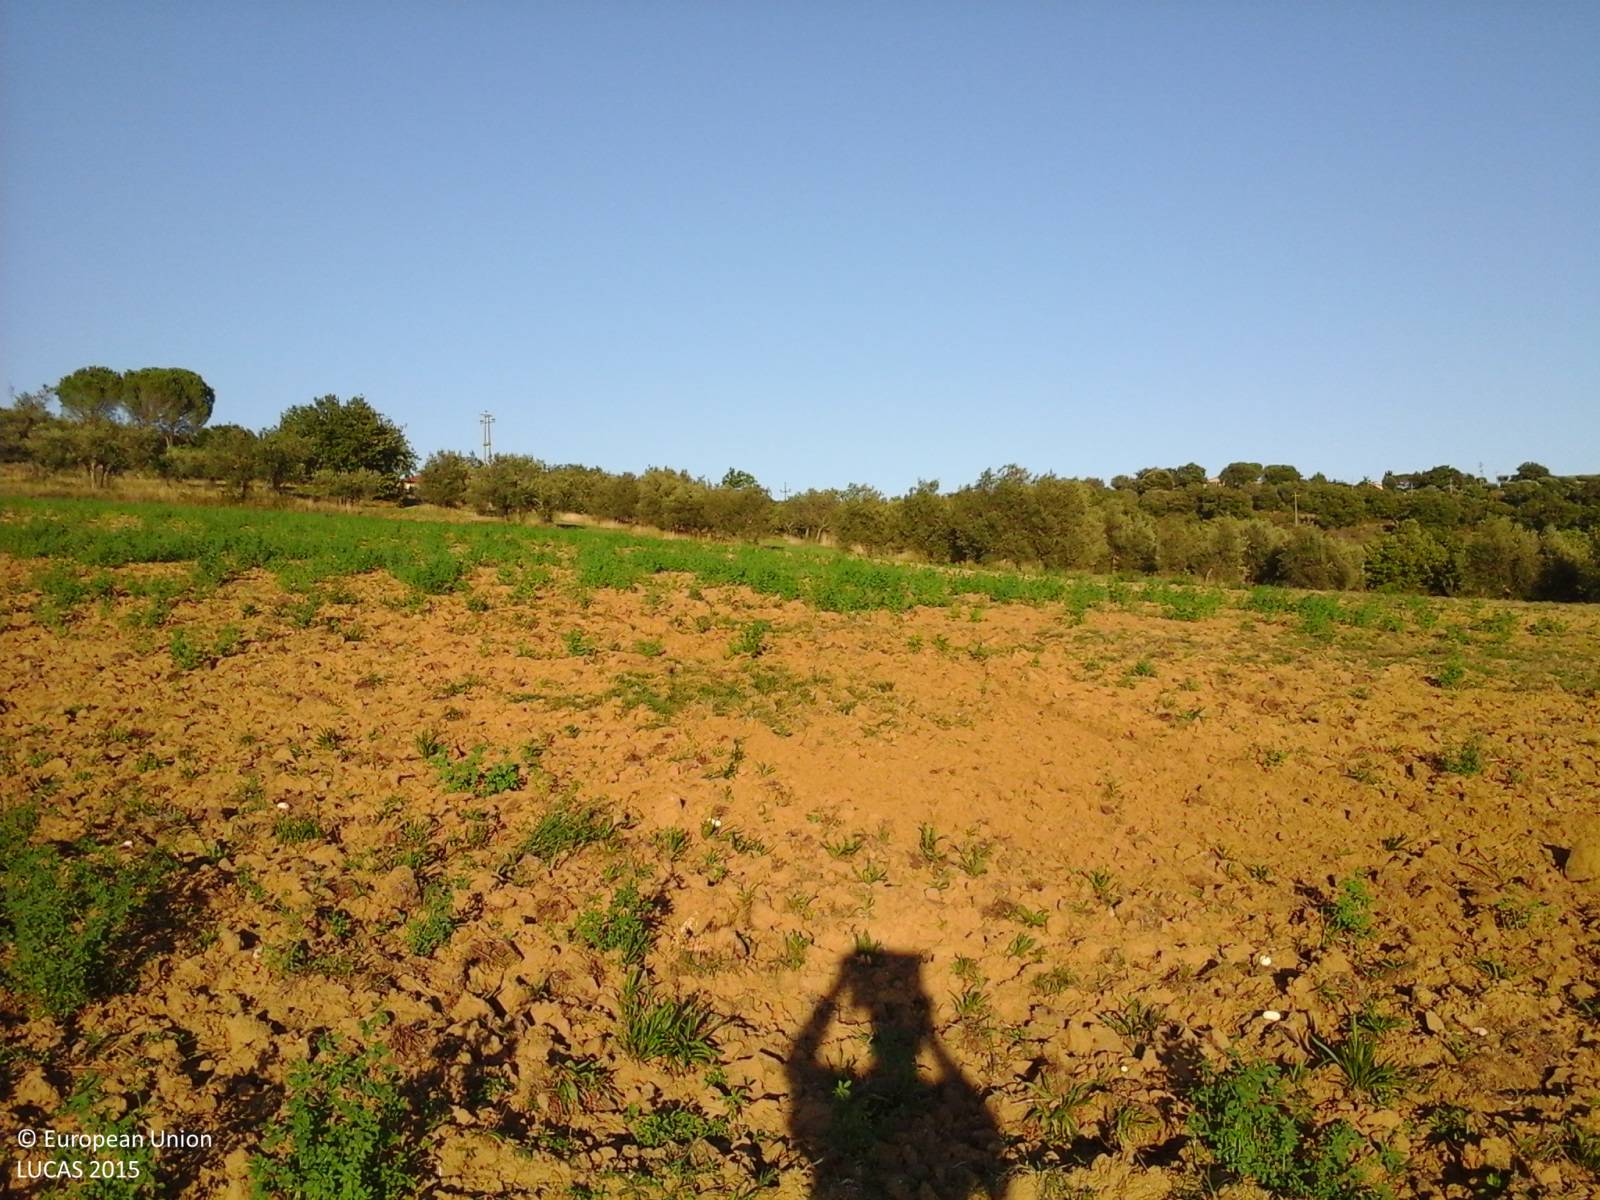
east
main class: Cropland
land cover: Lucerne
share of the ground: 50 - 75 %
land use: Agriculture (excluding fallow land and kitchen gardens)
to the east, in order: Lucerne; Ditches and canals; Grassland without tree/shrub cover; Olive groves; Single bushes/trees; Shrubland without tree cover; Tracks; Shrubland with sparse tree cover; Electric lines; Broadleaved woodland
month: September
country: IT
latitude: 43.0447
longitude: 12.2398
